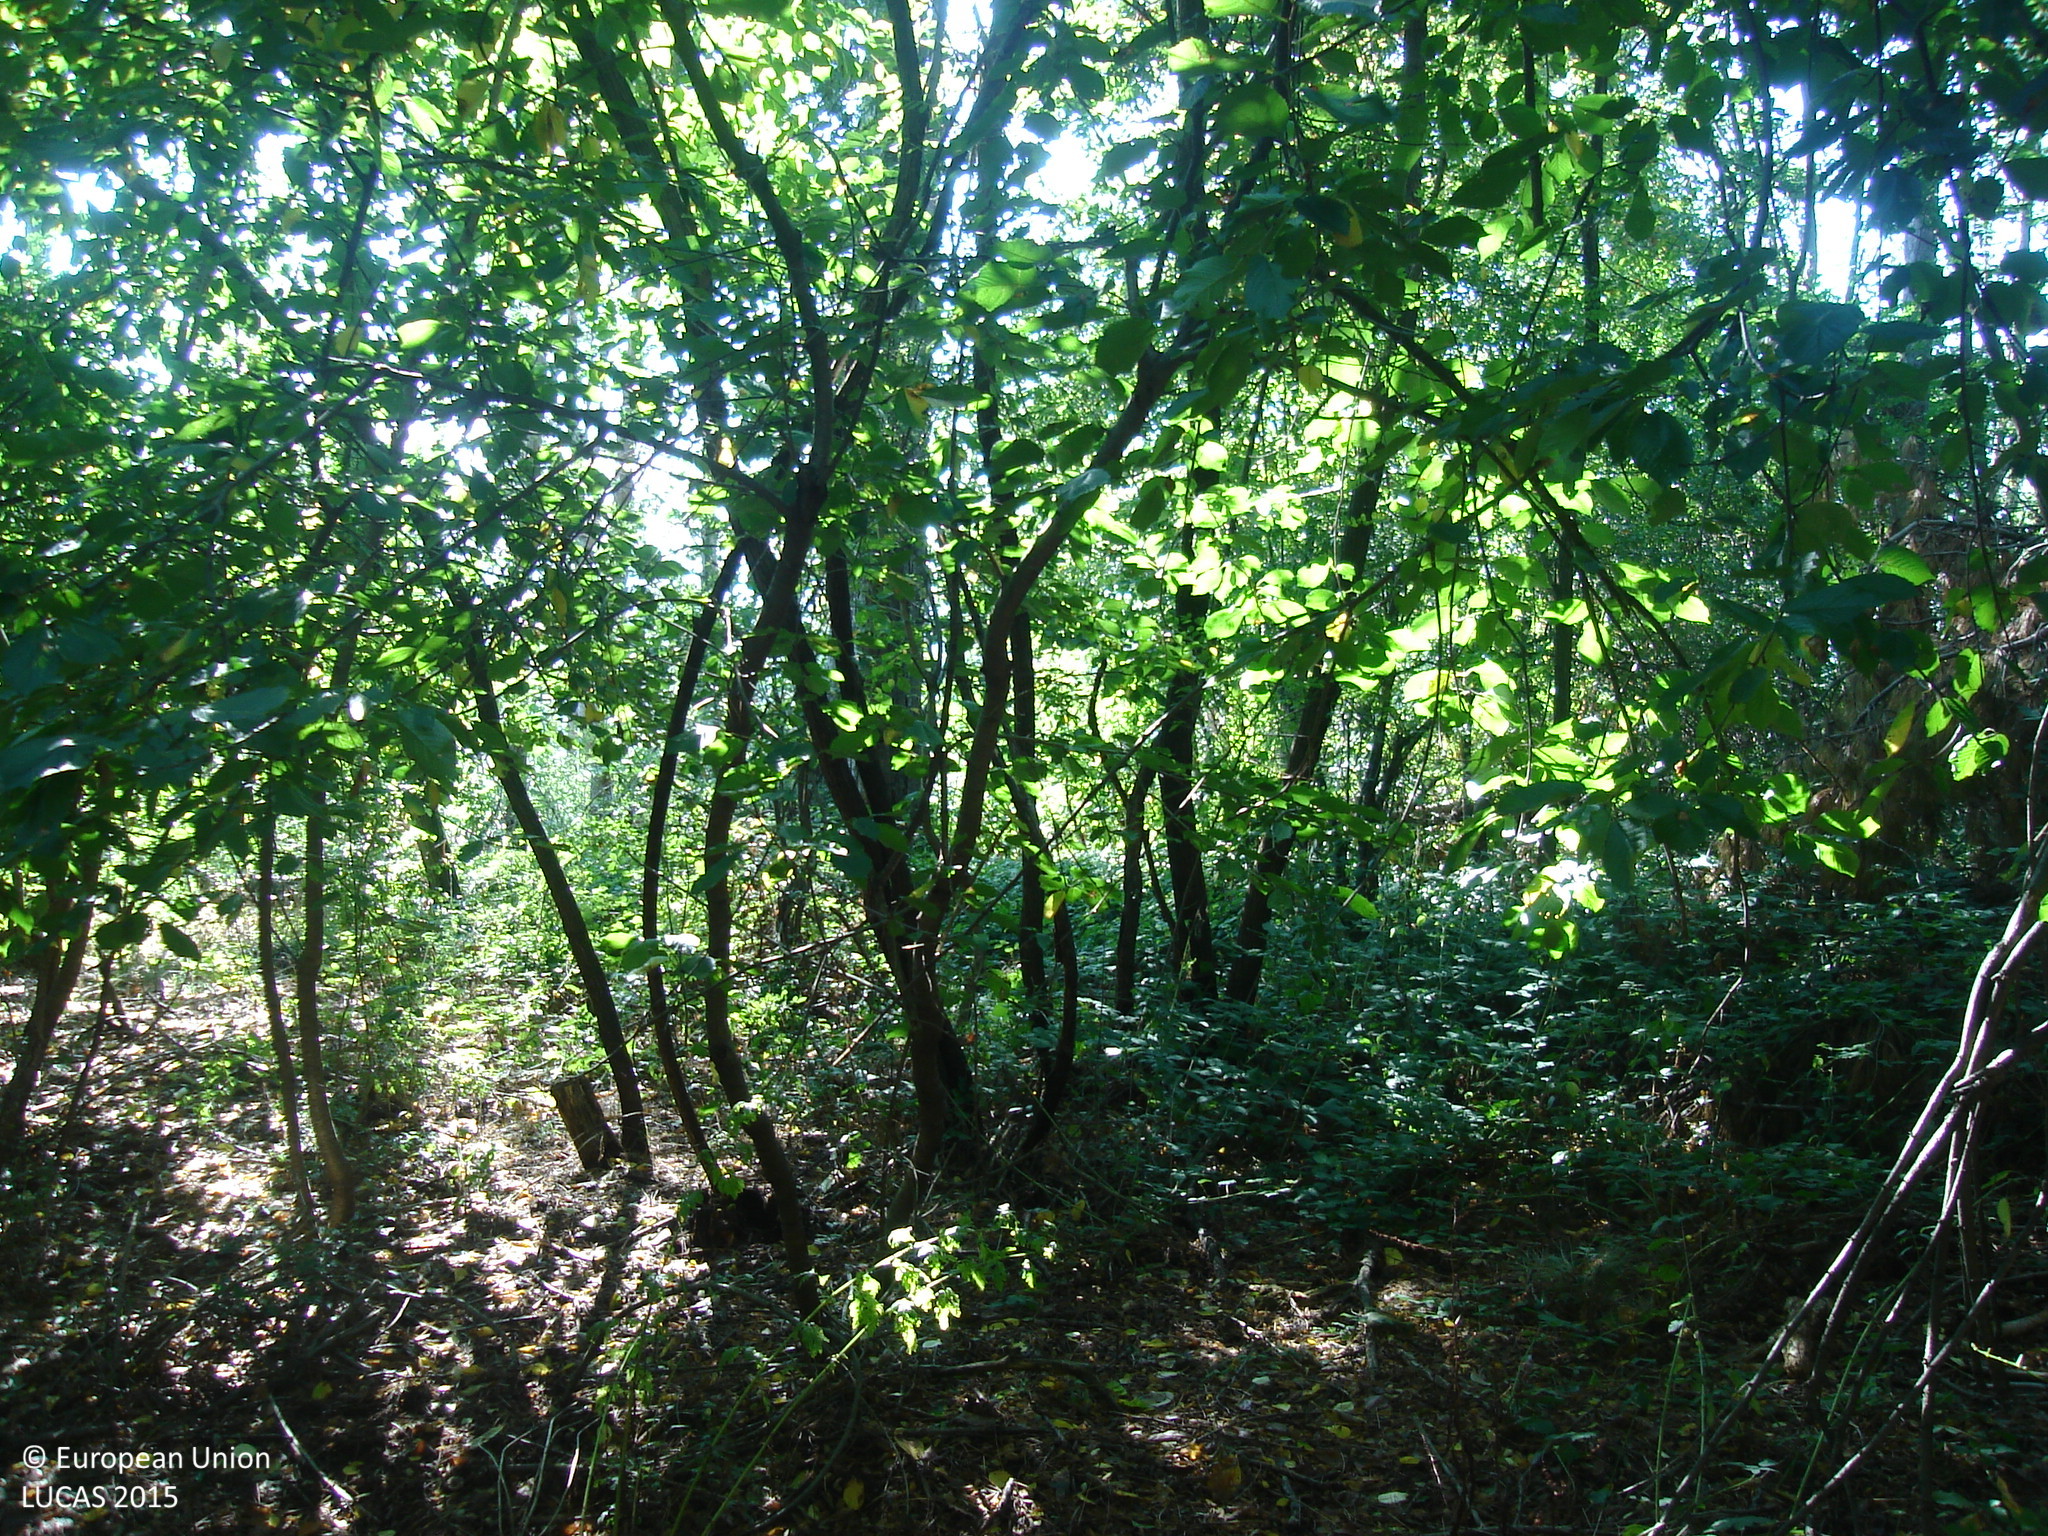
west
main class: Woodland
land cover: Broadleaved woodland
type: mesophytic deciduous forest
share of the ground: > 75 %
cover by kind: broadleaved forest trees 80 %, consolidated bare surface 15 %, shrubs 5 %
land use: Forestry
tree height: > 5 m
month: September
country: BG
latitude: 42.3648
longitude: 23.9186
